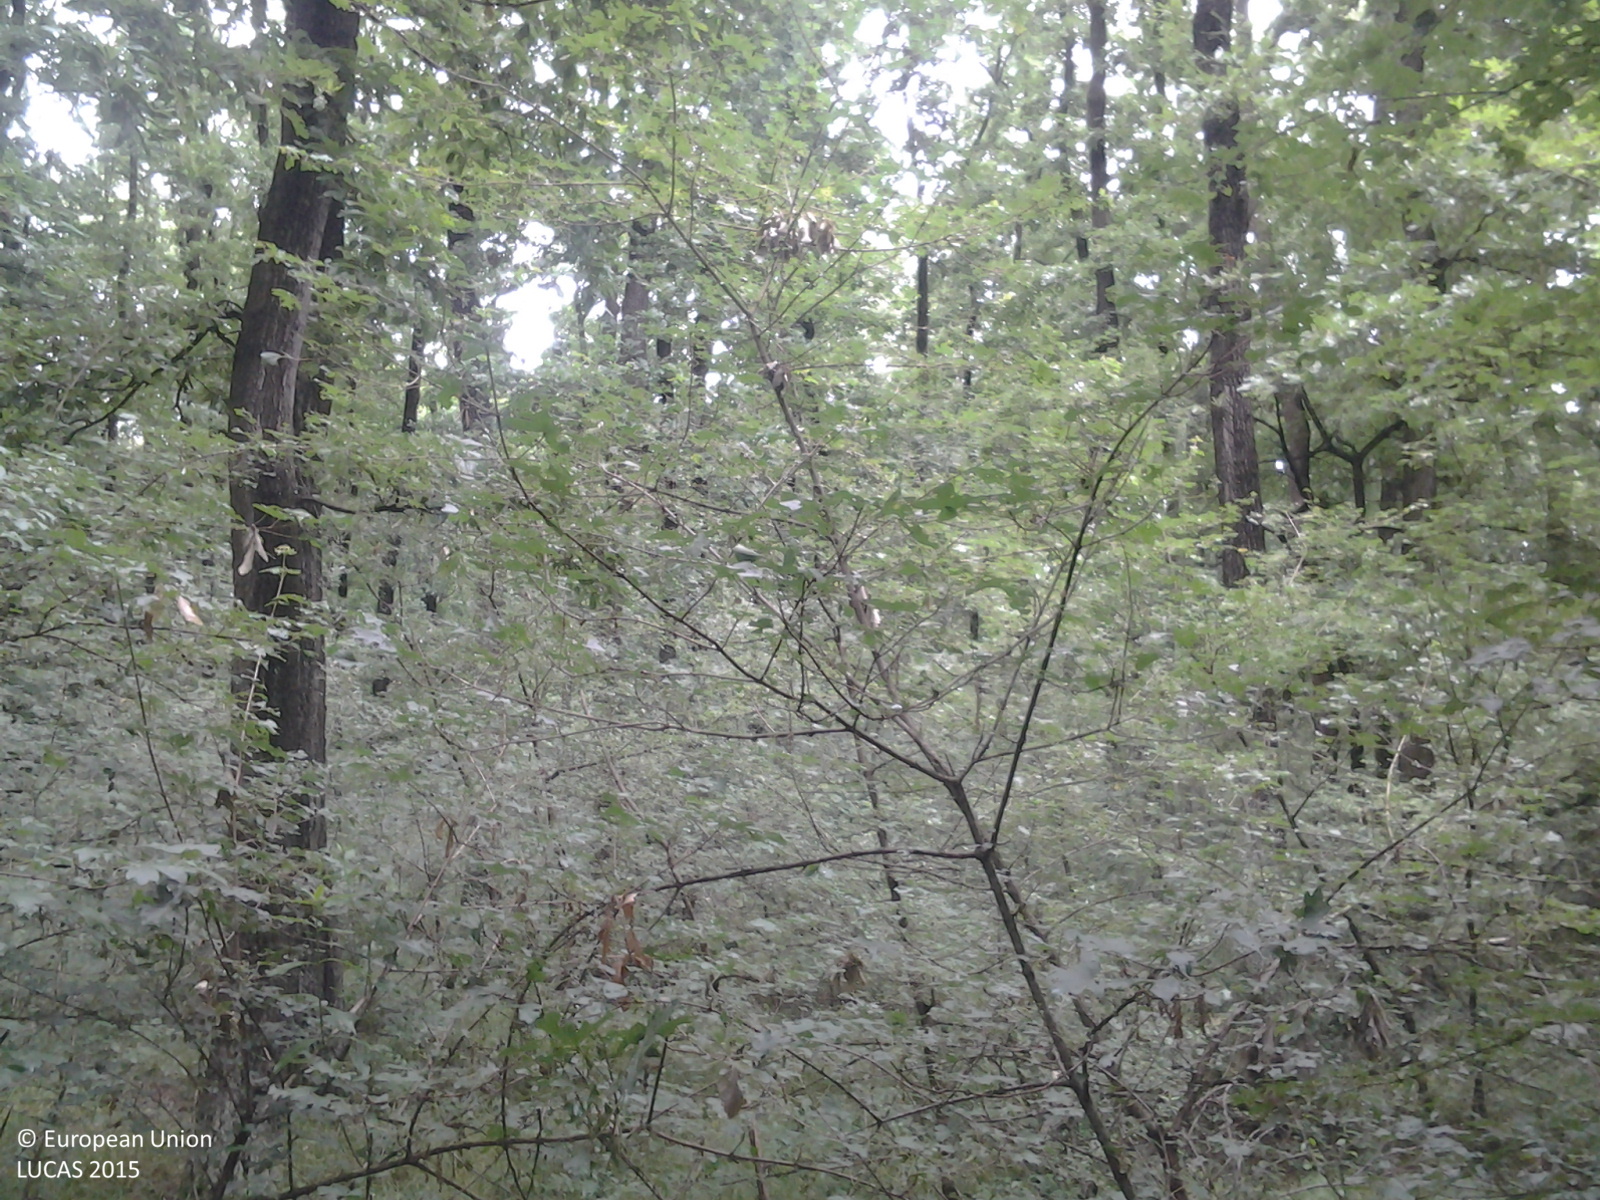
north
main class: Woodland
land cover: Broadleaved woodland
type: mesophytic deciduous forest
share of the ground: > 75 %
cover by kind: broadleaved forest trees 85 %, shrubs 10 %, herbaceous plants 5 %
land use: Forestry
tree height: > 5 m
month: June
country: HU
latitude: 46.9030
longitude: 17.2119
